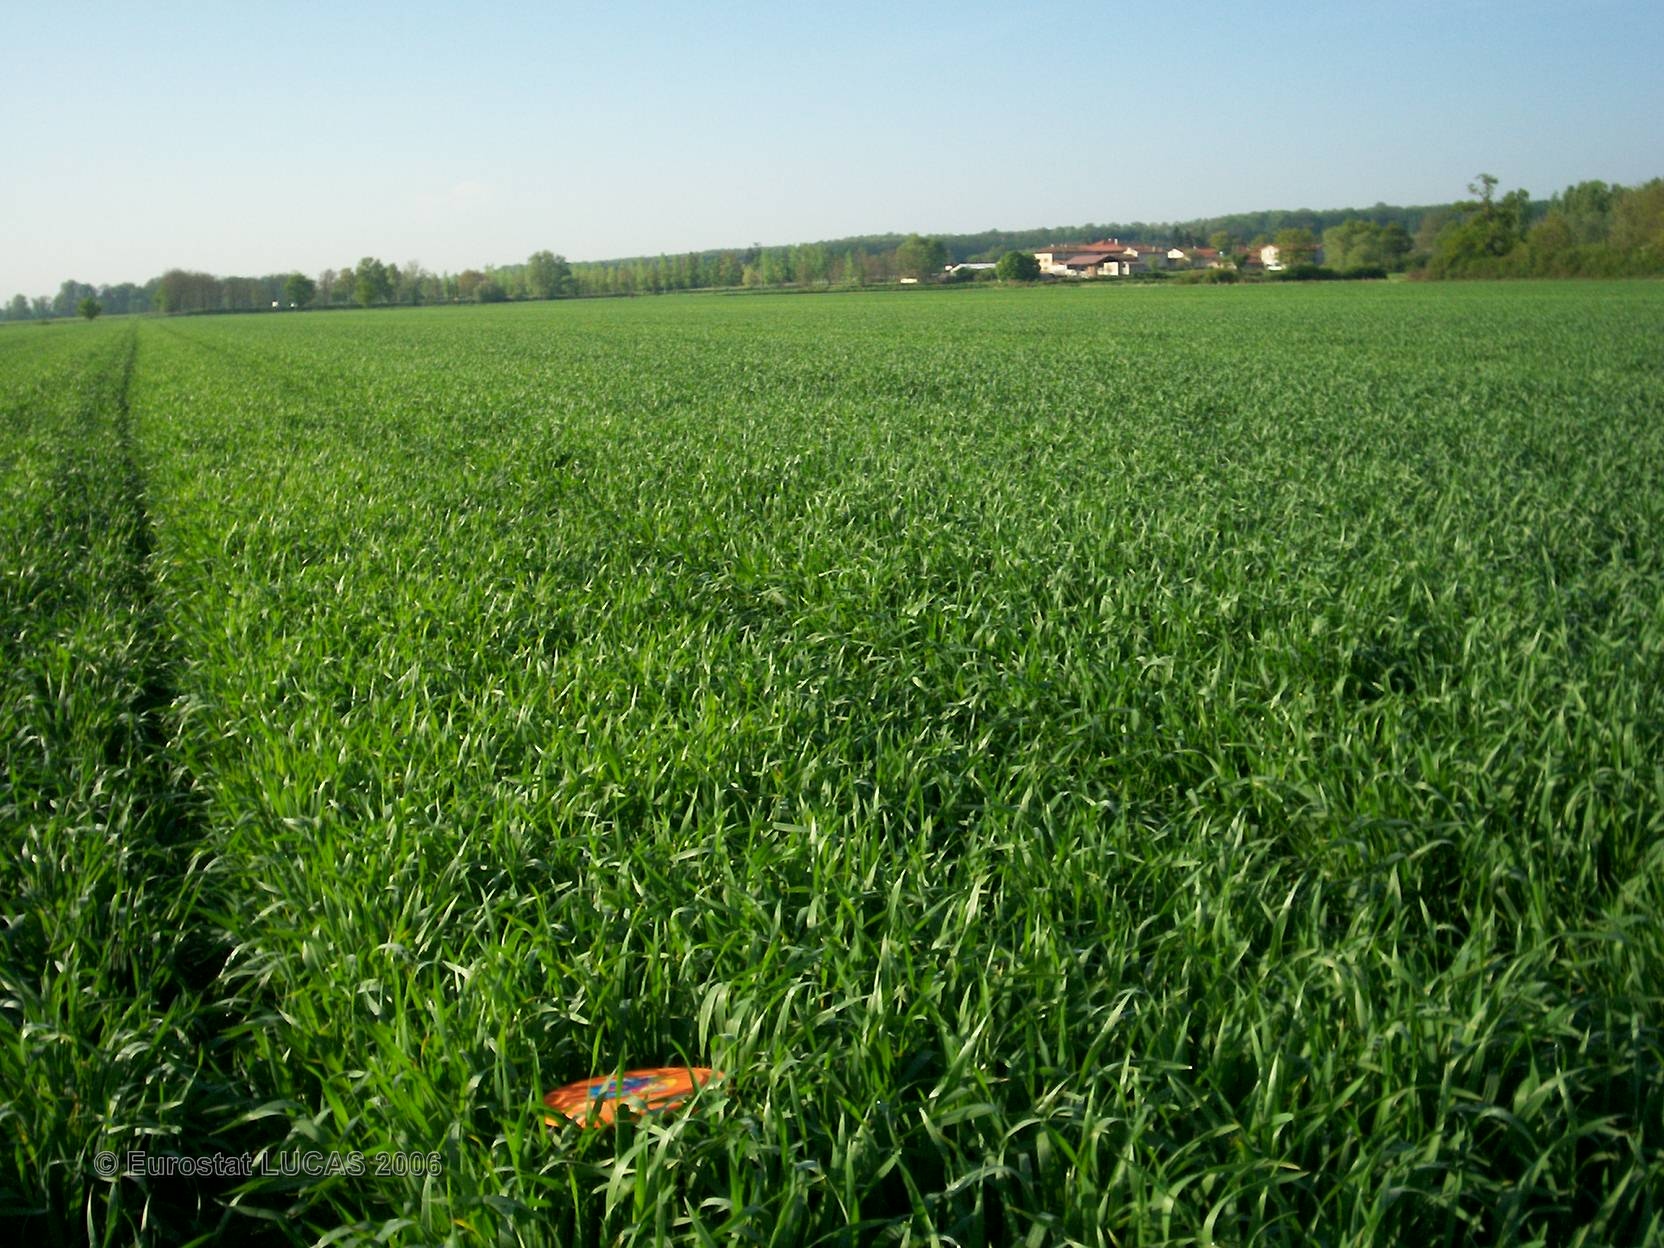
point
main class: Cropland
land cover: Common wheat
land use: Agriculture (excluding fallow land and kitchen gardens)
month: May
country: FR
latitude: 45.7951
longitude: 4.1746
